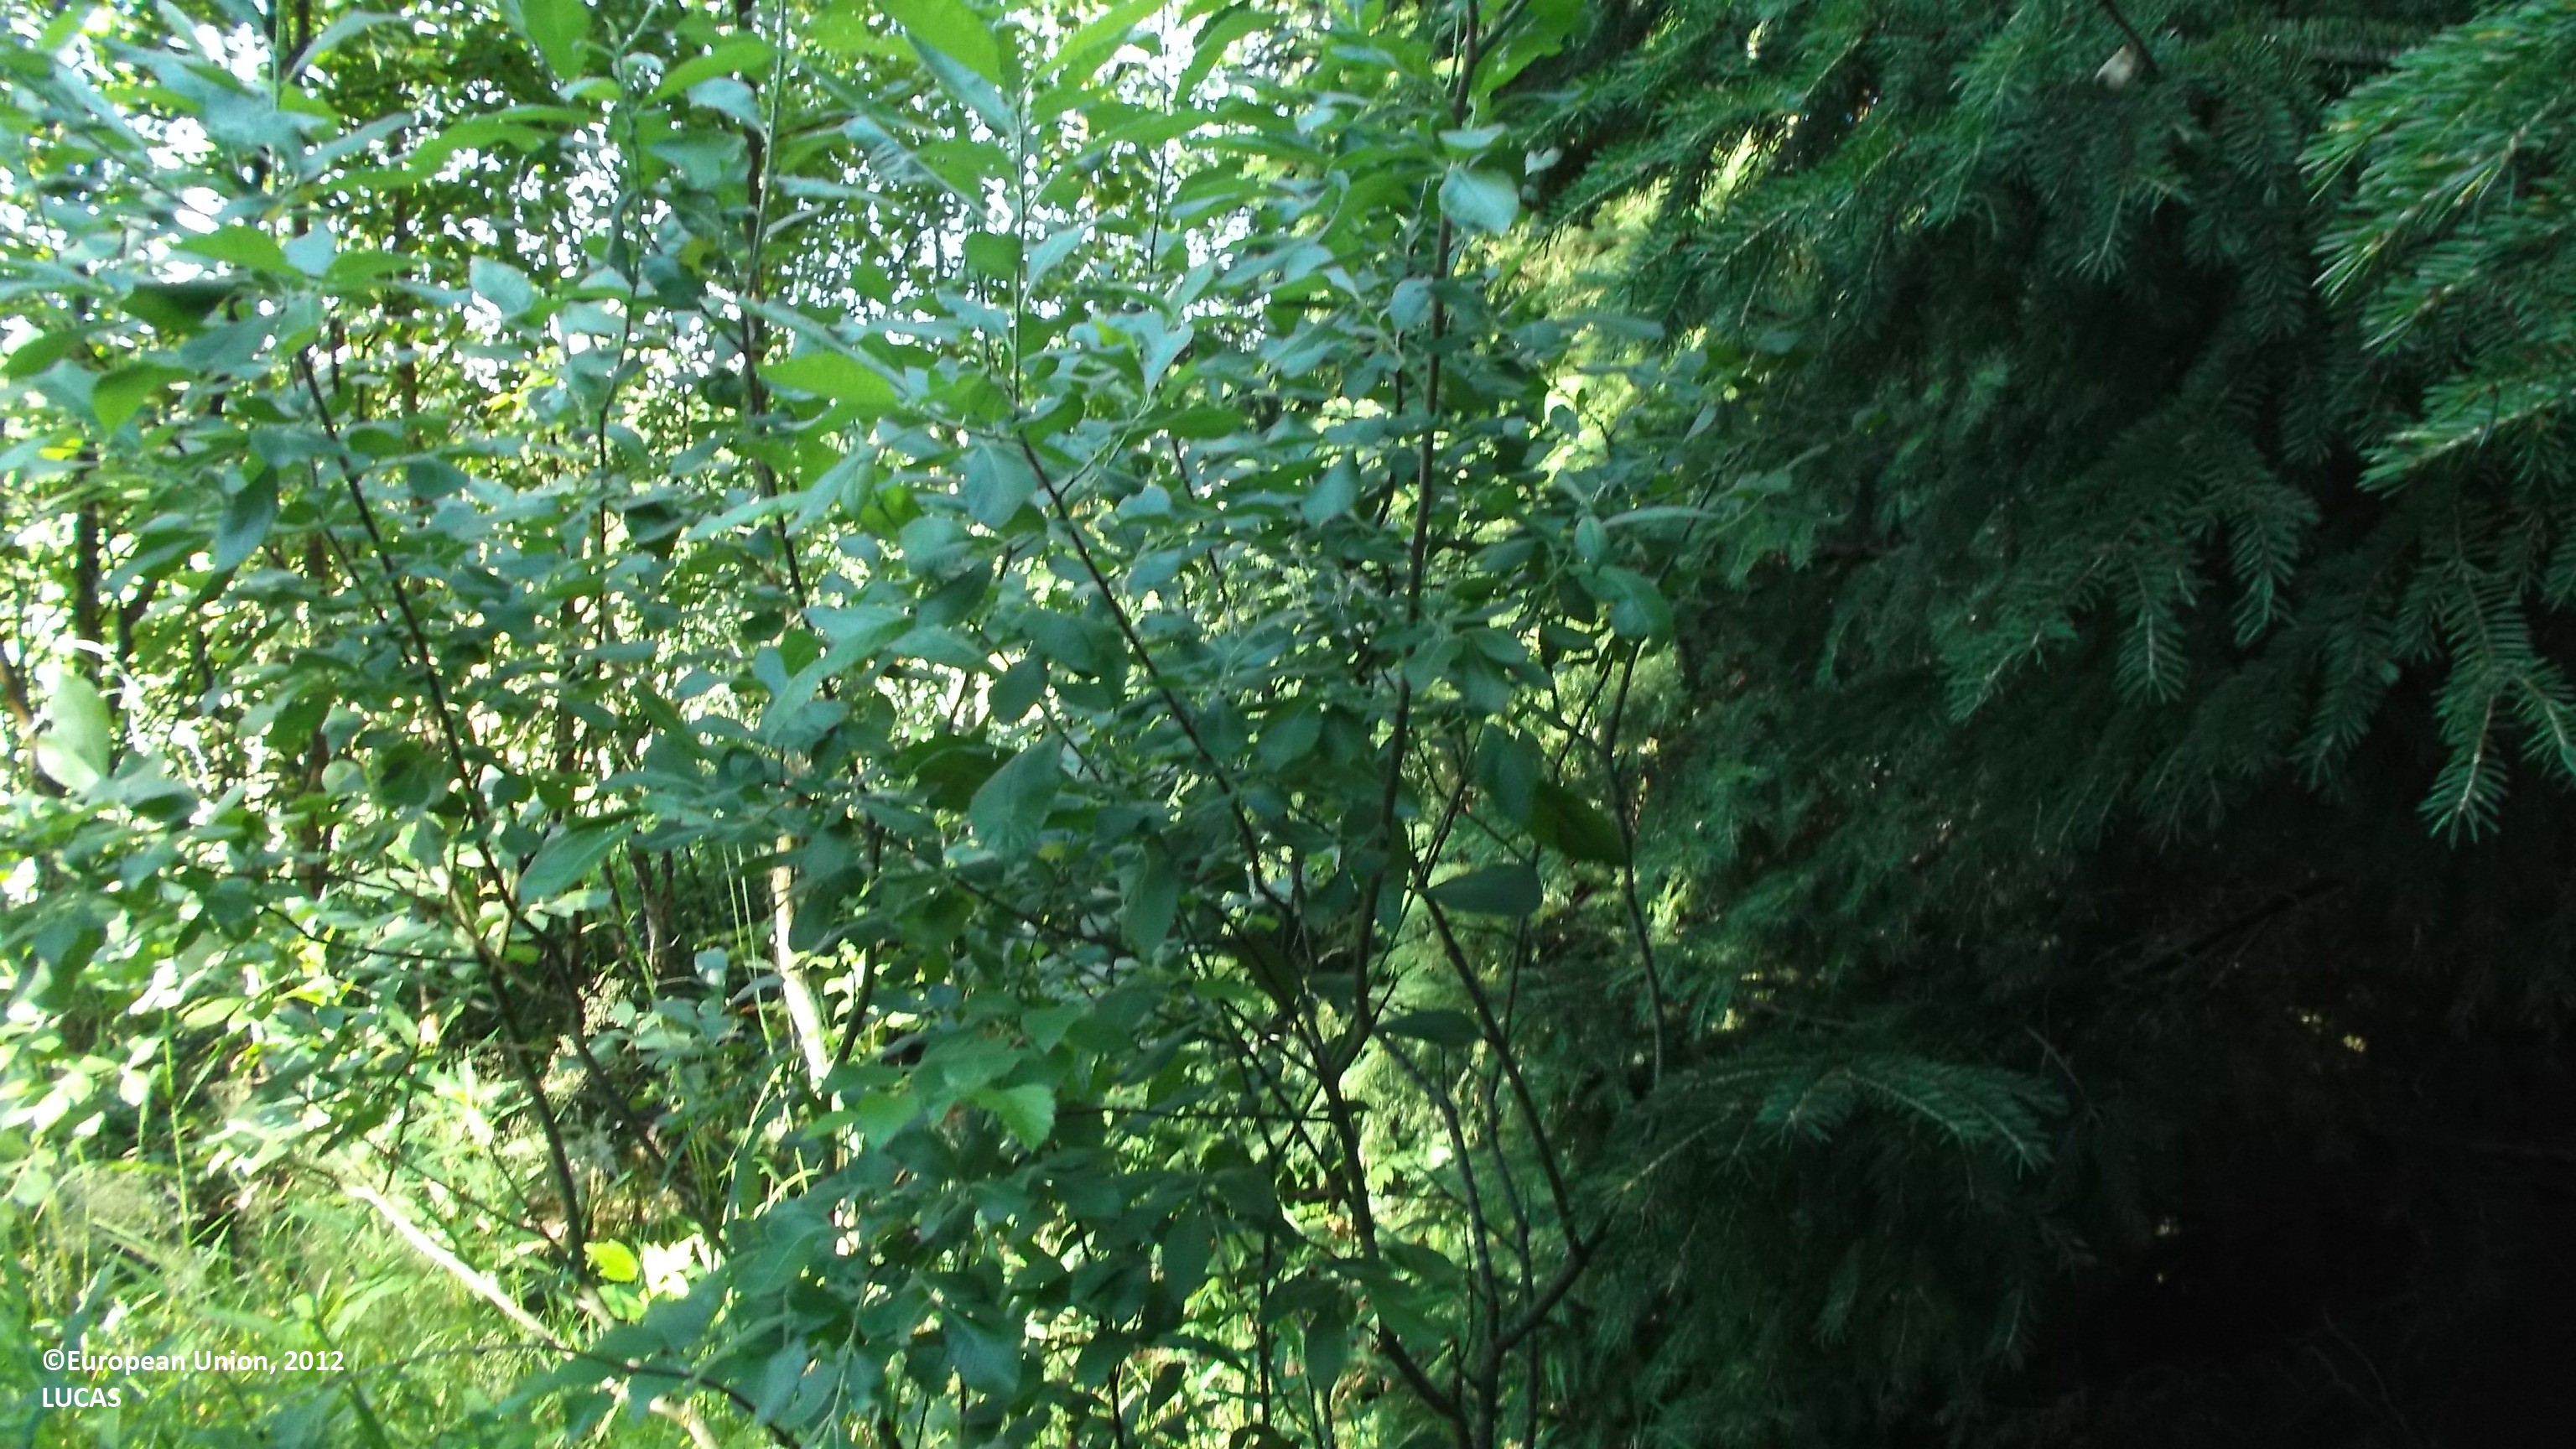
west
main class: Woodland
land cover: Spruce dominated mixed woodland
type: boreal forest
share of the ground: 50 - 75 %
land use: Forestry
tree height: > 5 m
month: July
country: FI
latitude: 63.6445
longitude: 22.9535
